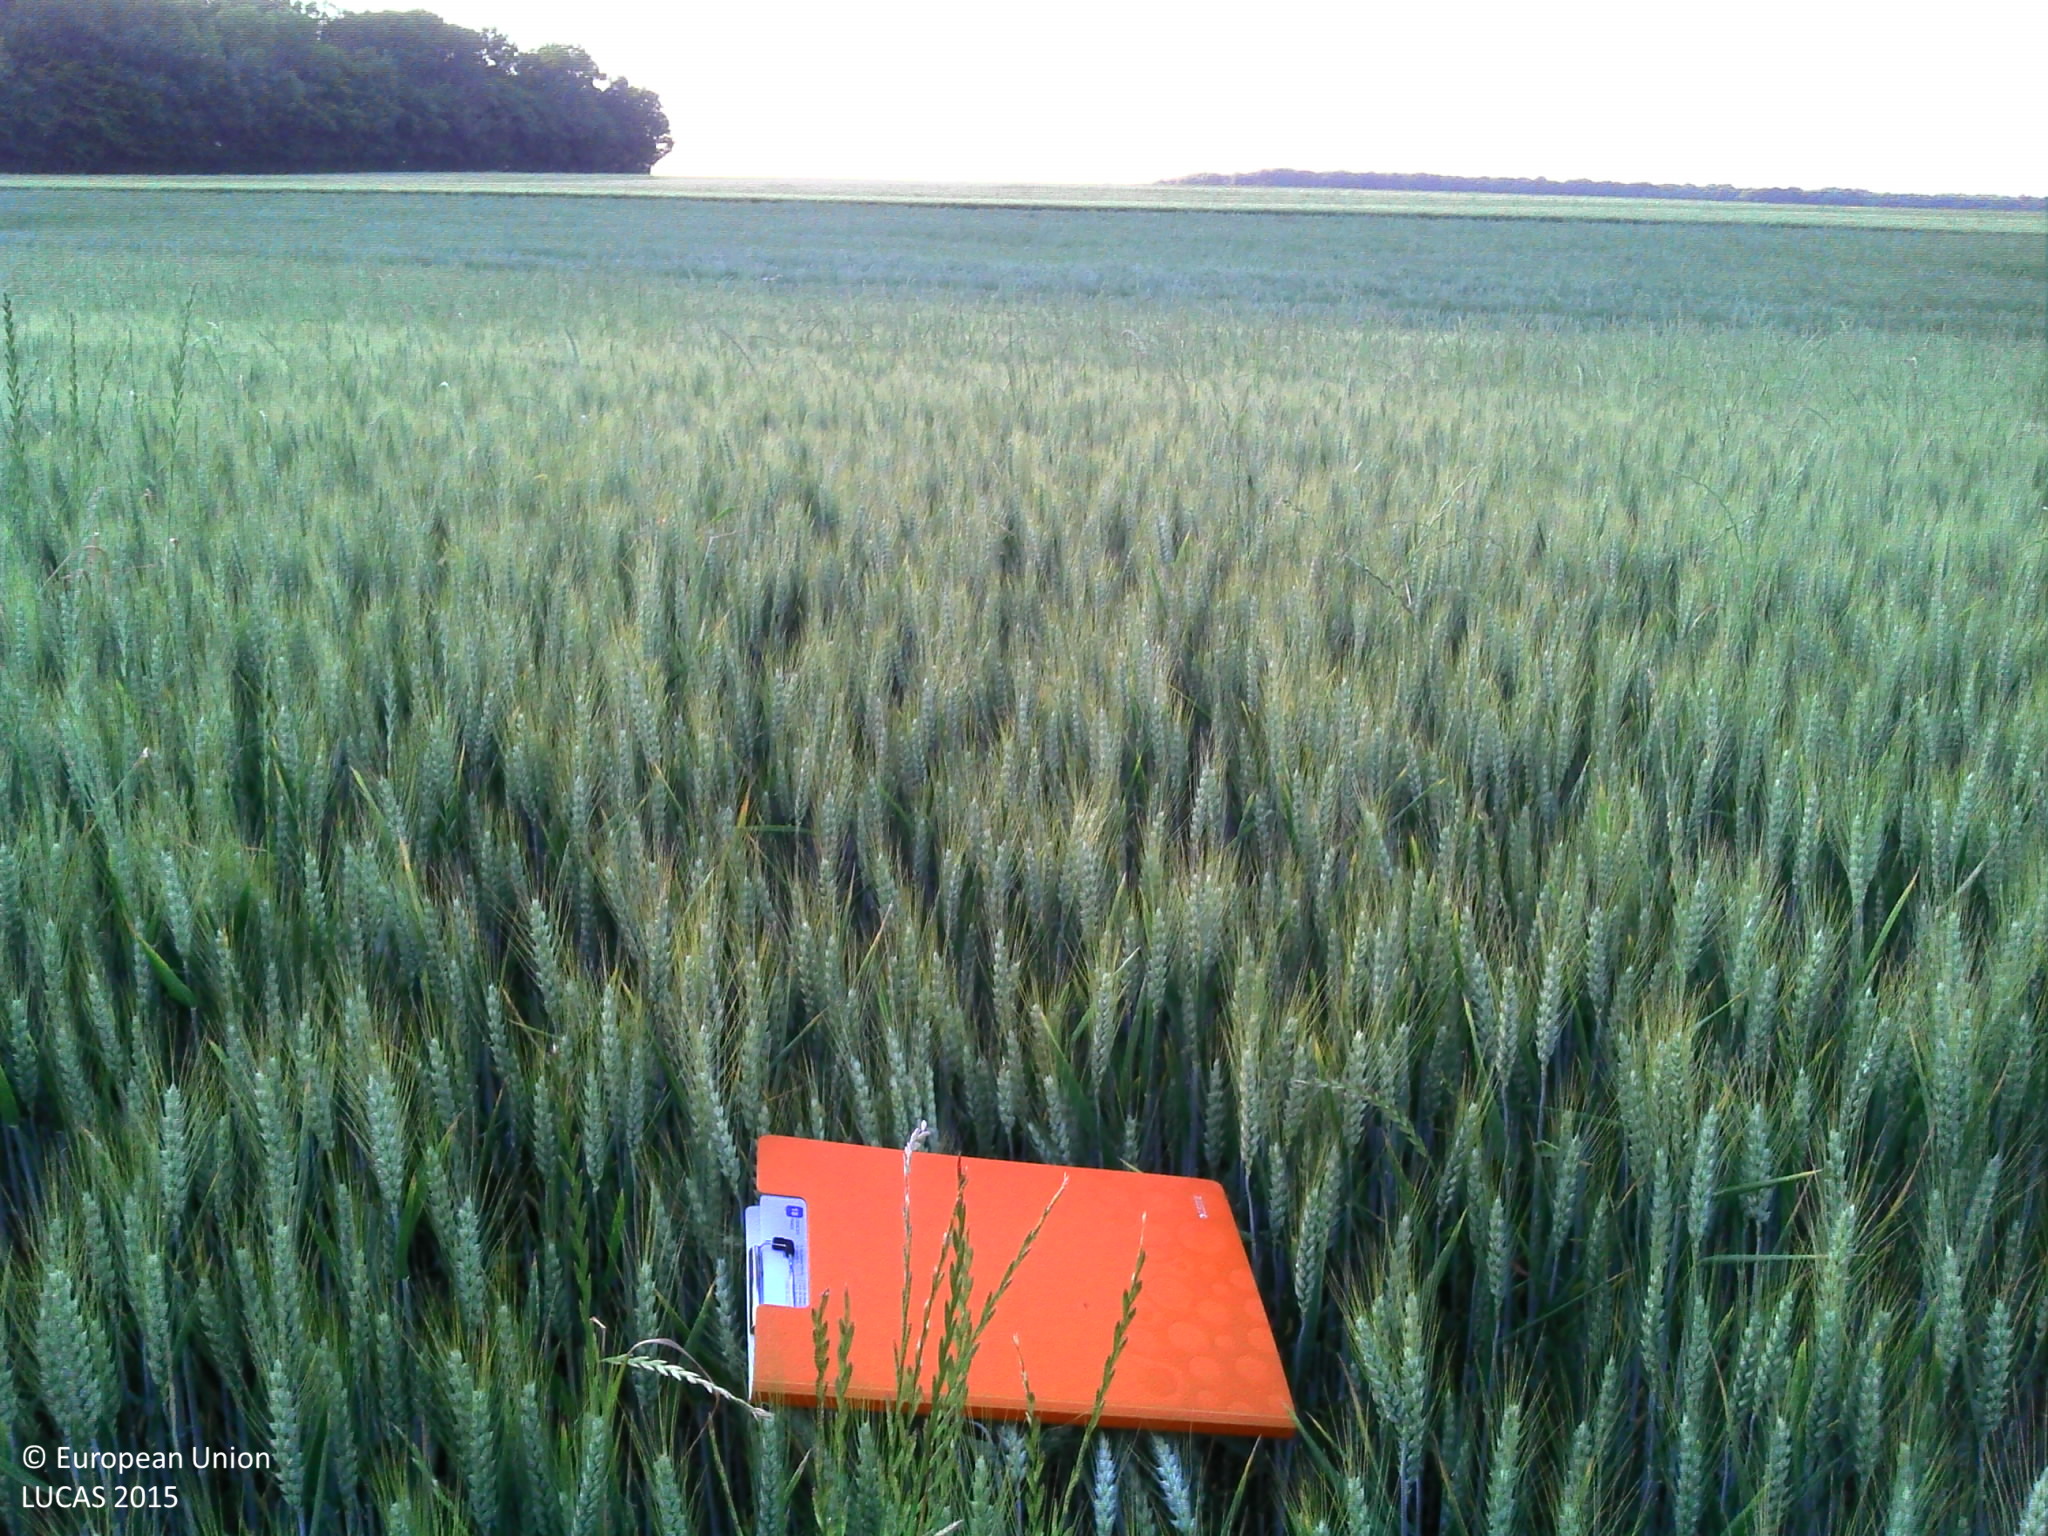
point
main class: Cropland
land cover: Common wheat
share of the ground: > 75 %
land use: Agriculture (excluding fallow land and kitchen gardens)
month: June
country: FR
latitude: 46.8580
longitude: 2.9260
